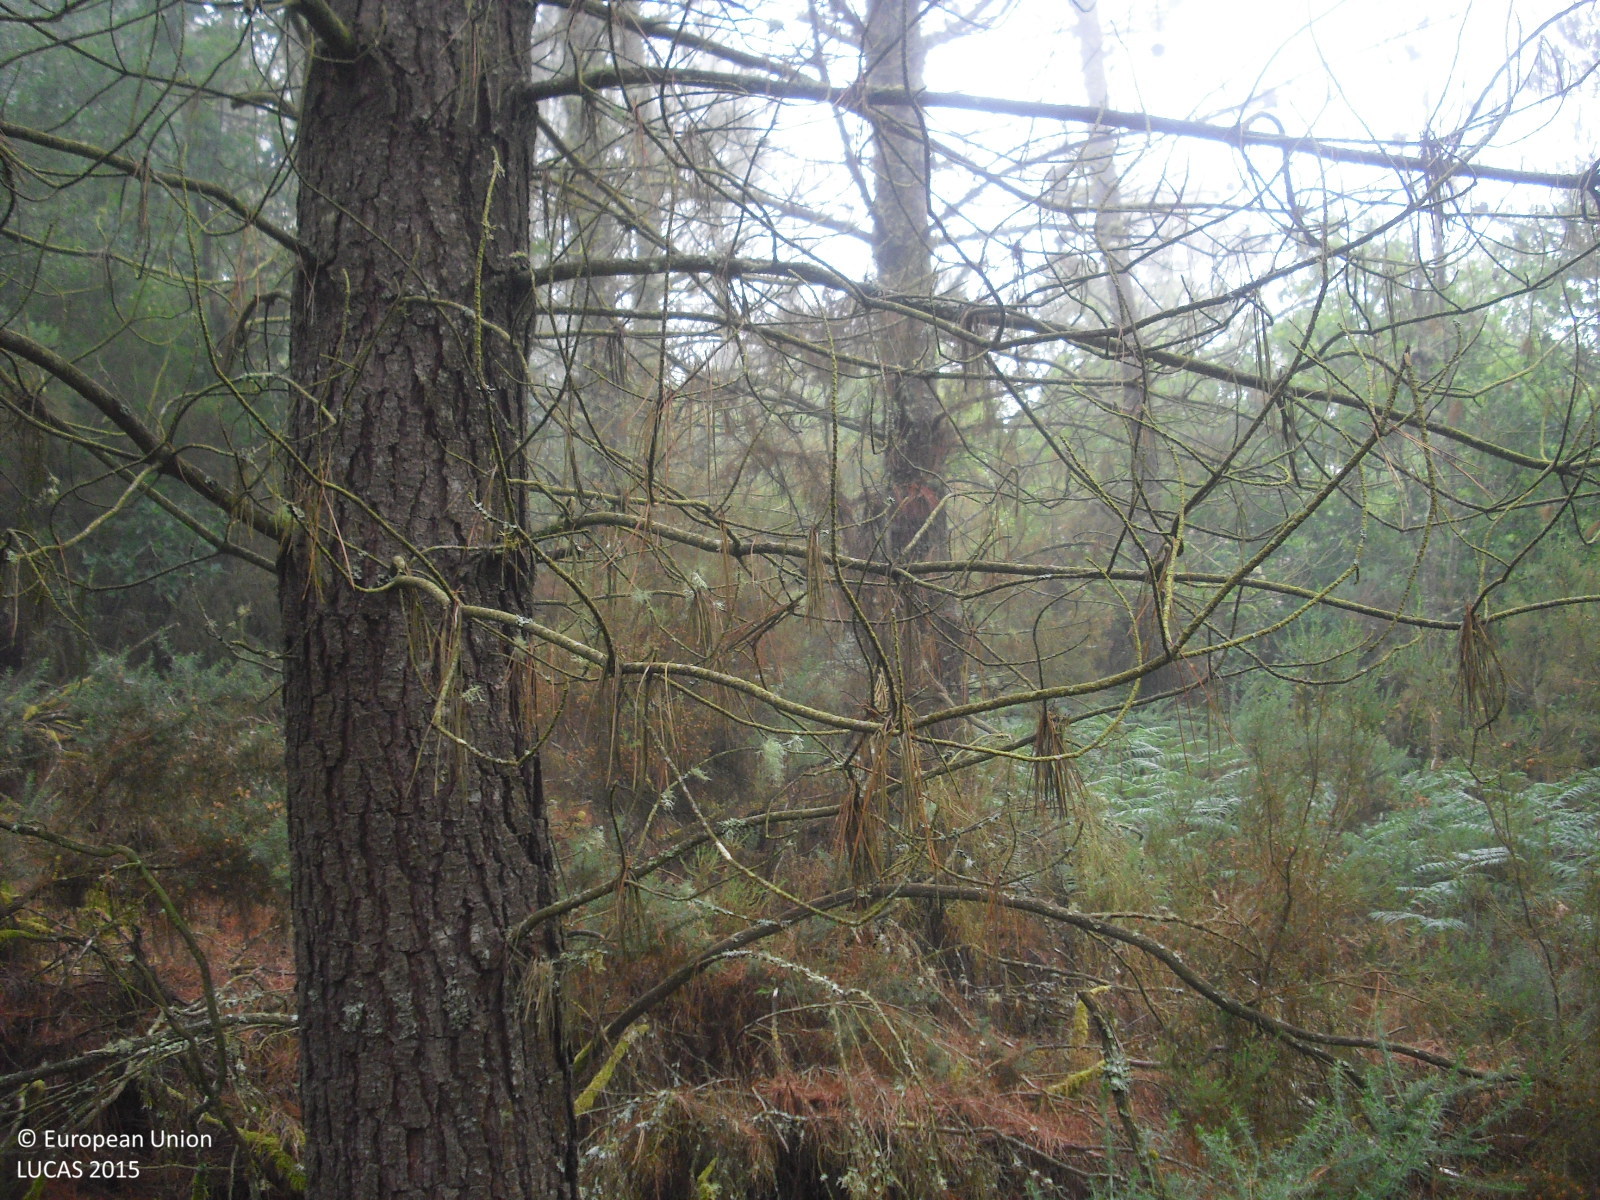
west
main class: Woodland
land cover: Pine dominated mixed woodland
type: hemiboreal forest and nemoral coniferous forest and mixed broadleaved-coniferous forest
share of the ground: 50 - 75 %
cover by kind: coniferous forest trees 40 %, broadleaved forest trees 30 %, shrubs 30 %
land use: Forestry
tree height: > 5 m
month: June
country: ES
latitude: 42.6795
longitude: -7.9375
